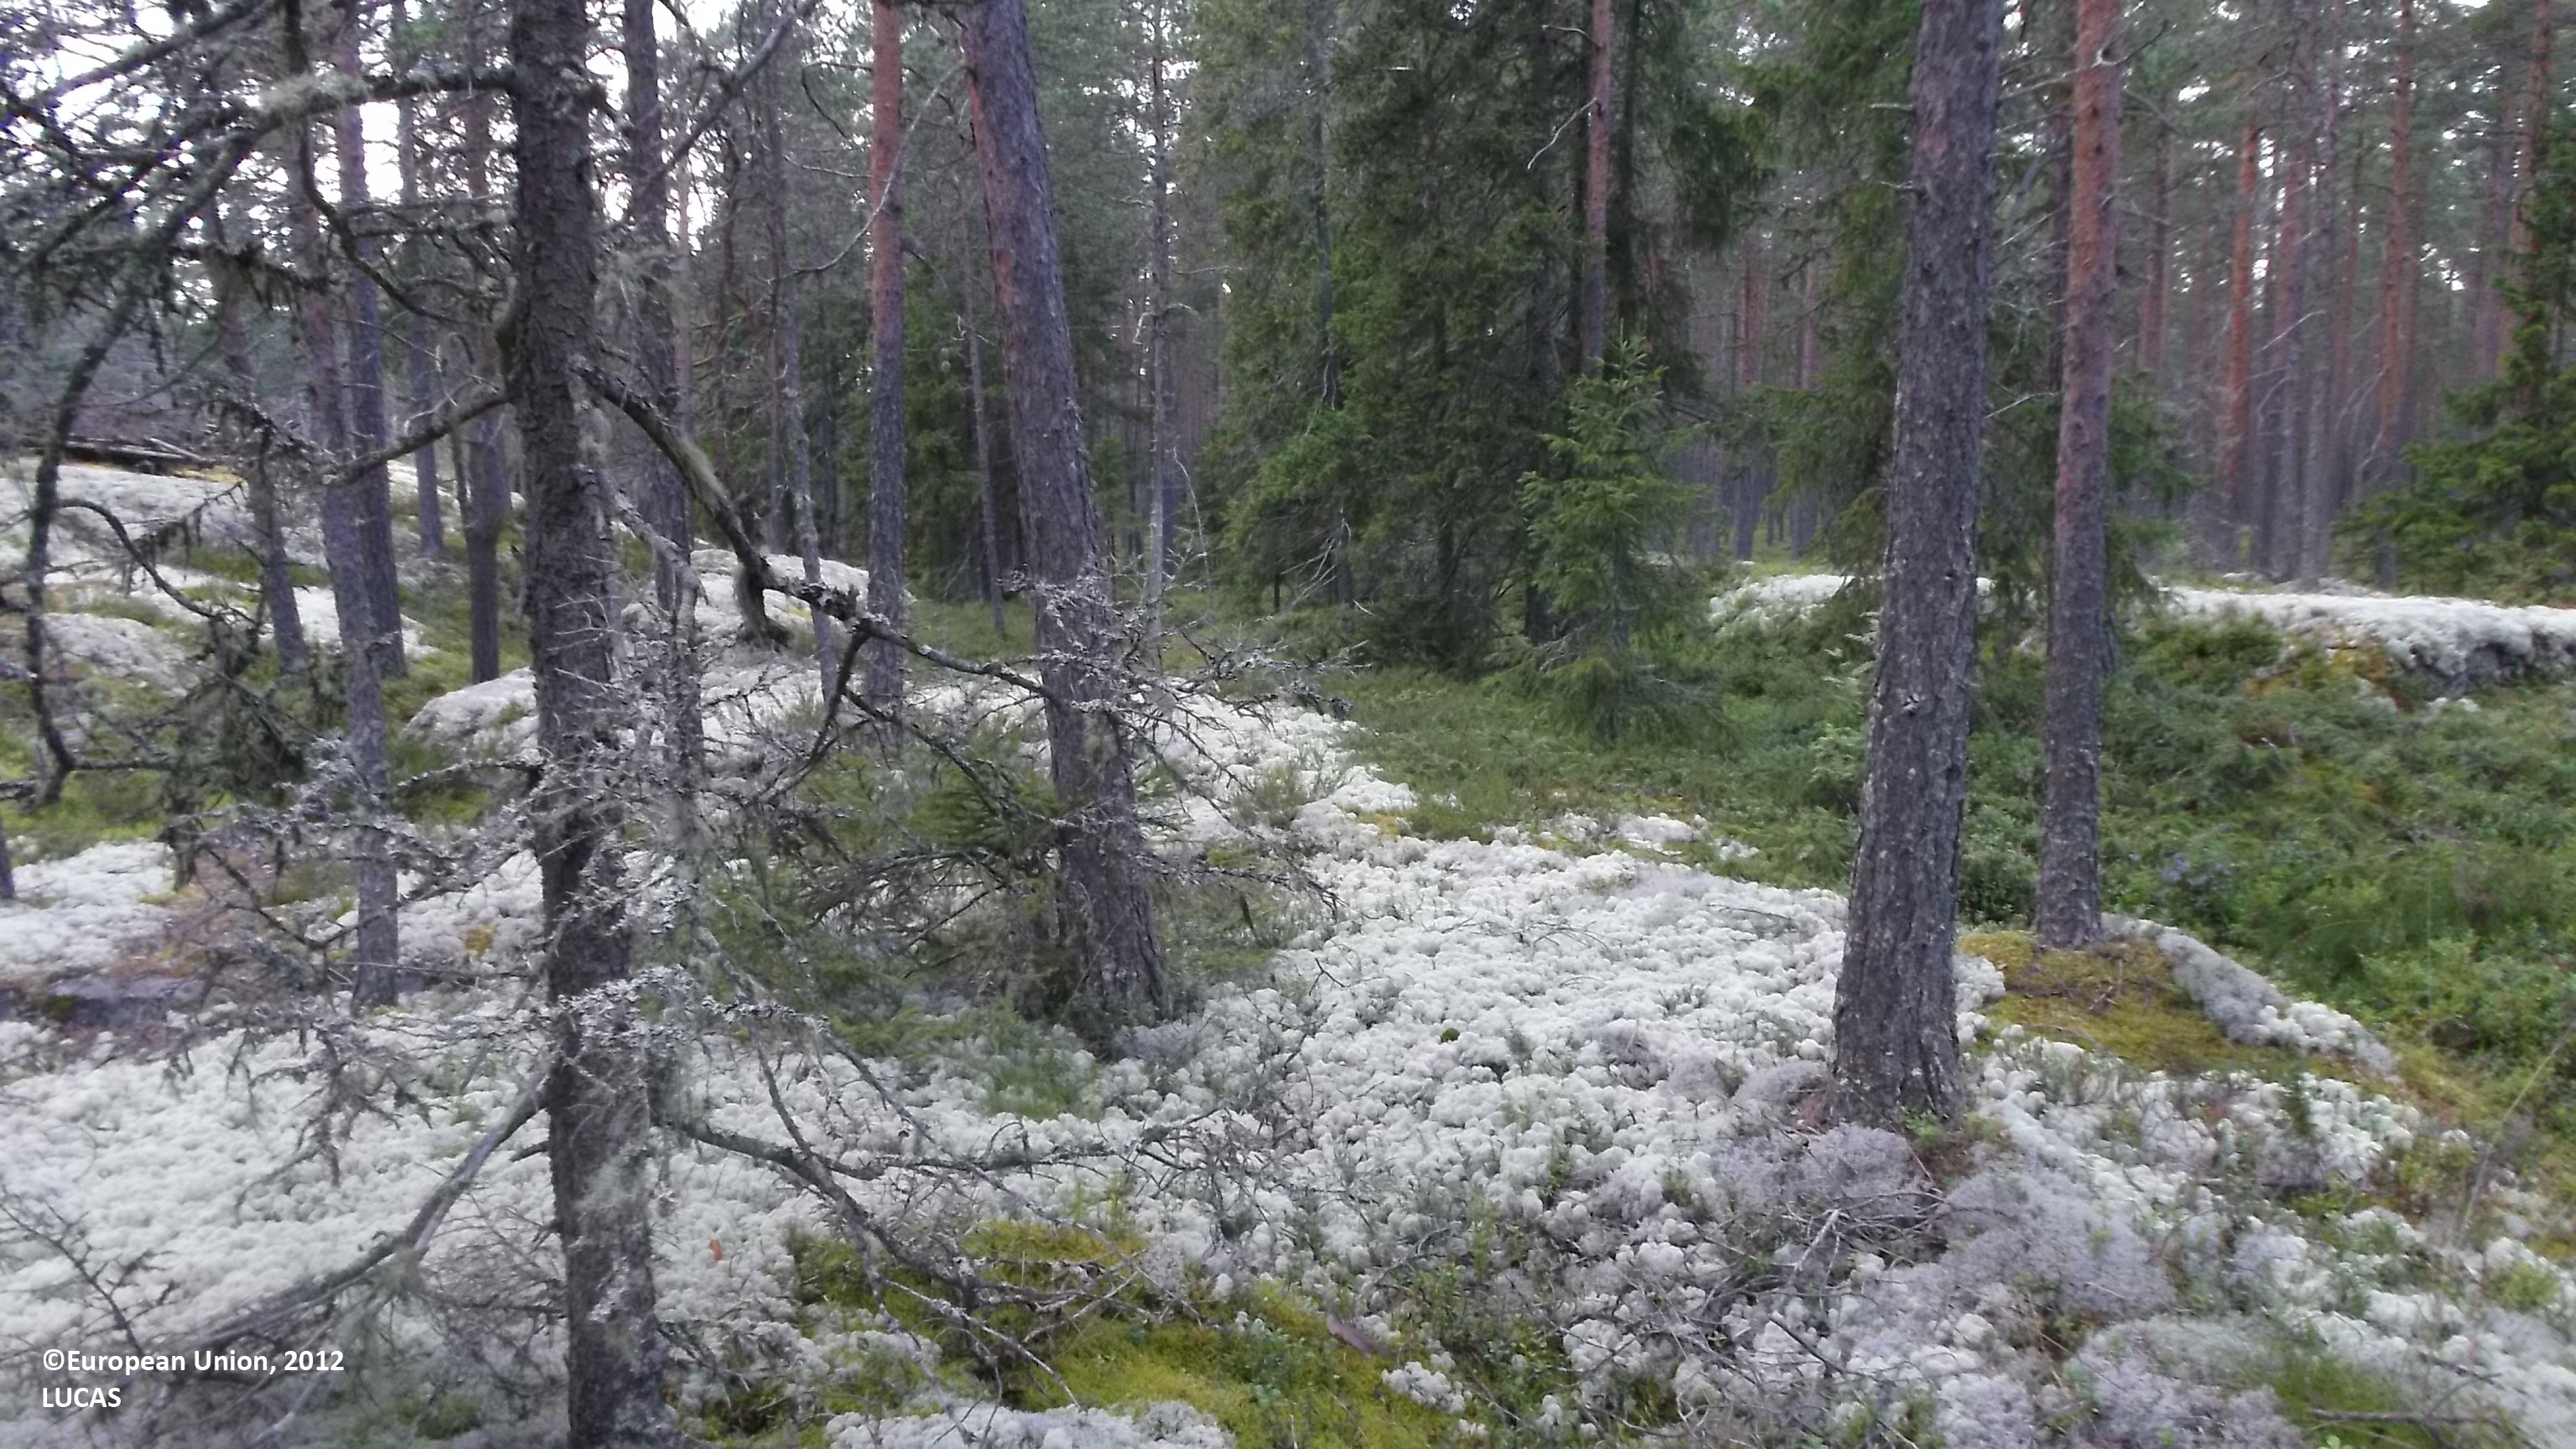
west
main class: Woodland
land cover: Pine dominated mixed woodland
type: boreal forest
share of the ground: 25 - 50 %
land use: Forestry
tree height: > 5 m
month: August
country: FI
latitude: 64.0168
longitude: 23.5393
